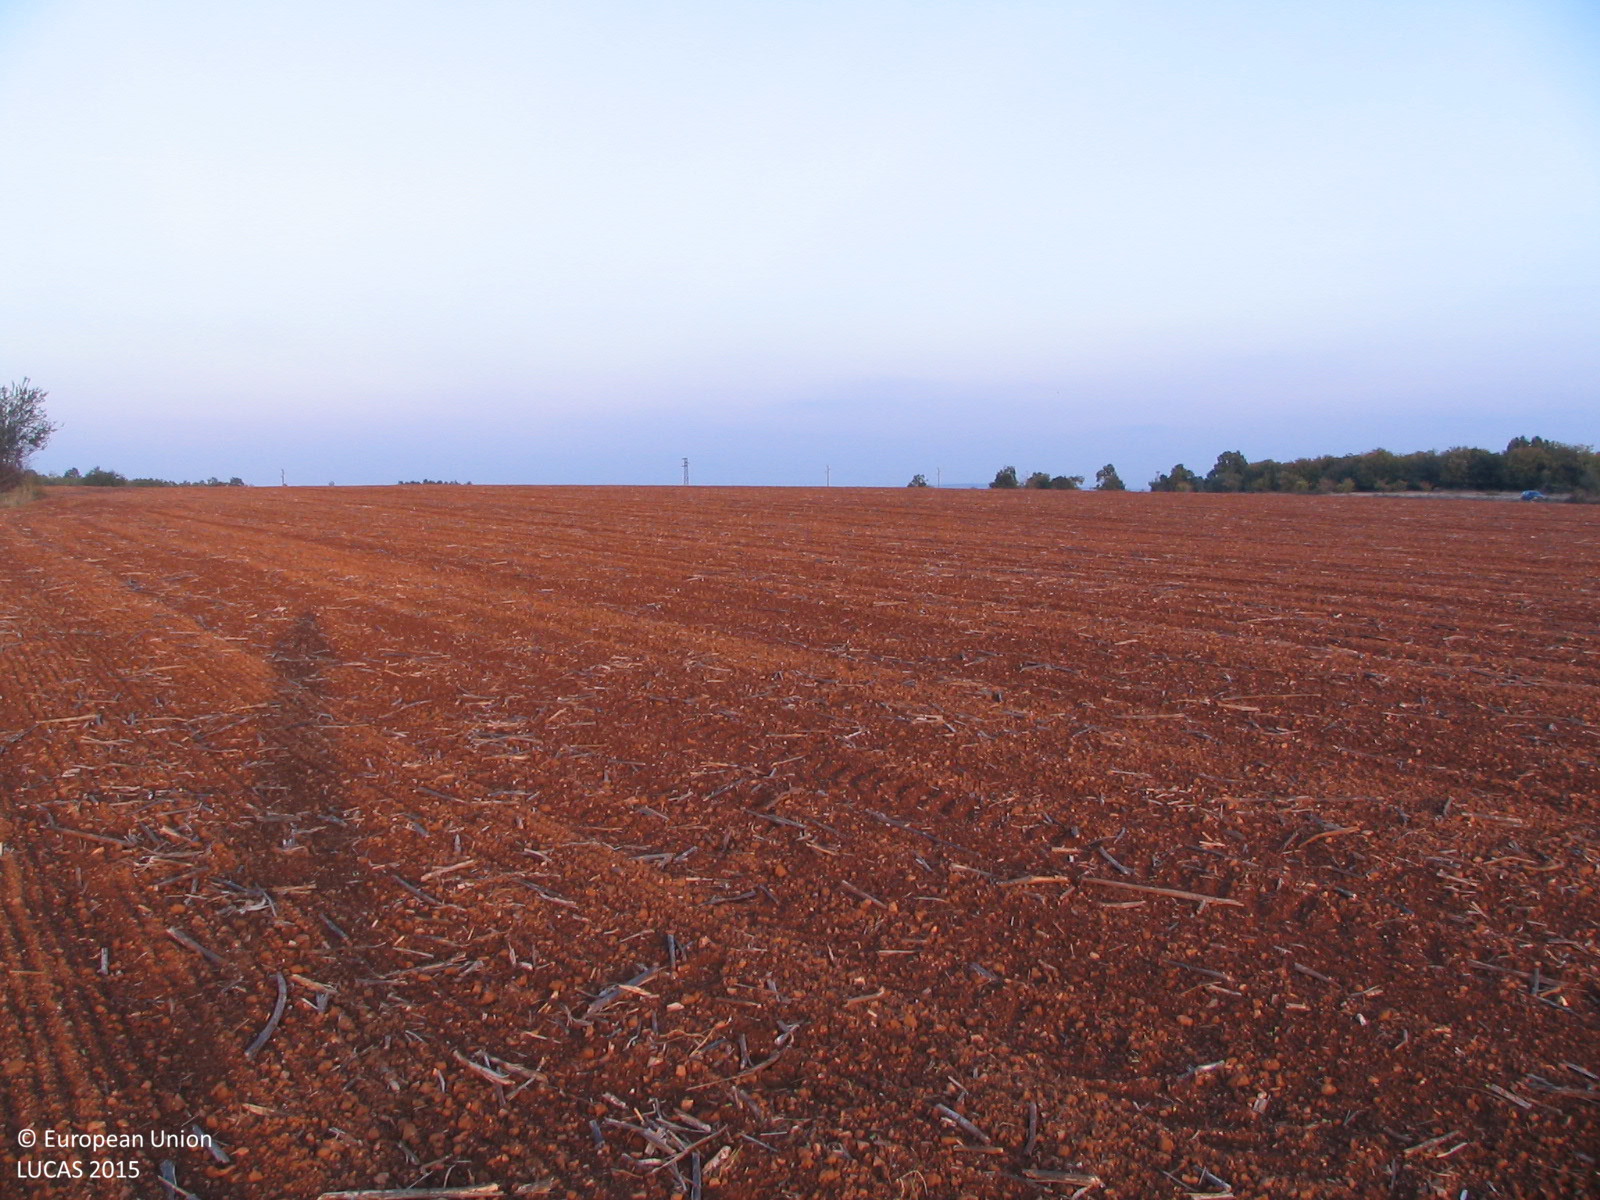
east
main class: Cropland
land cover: Sunflower
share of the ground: < 10 %
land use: Agriculture (excluding fallow land and kitchen gardens)
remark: Harvested field
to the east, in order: Sunflower
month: October
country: BG
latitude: 43.2447
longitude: 23.9038
